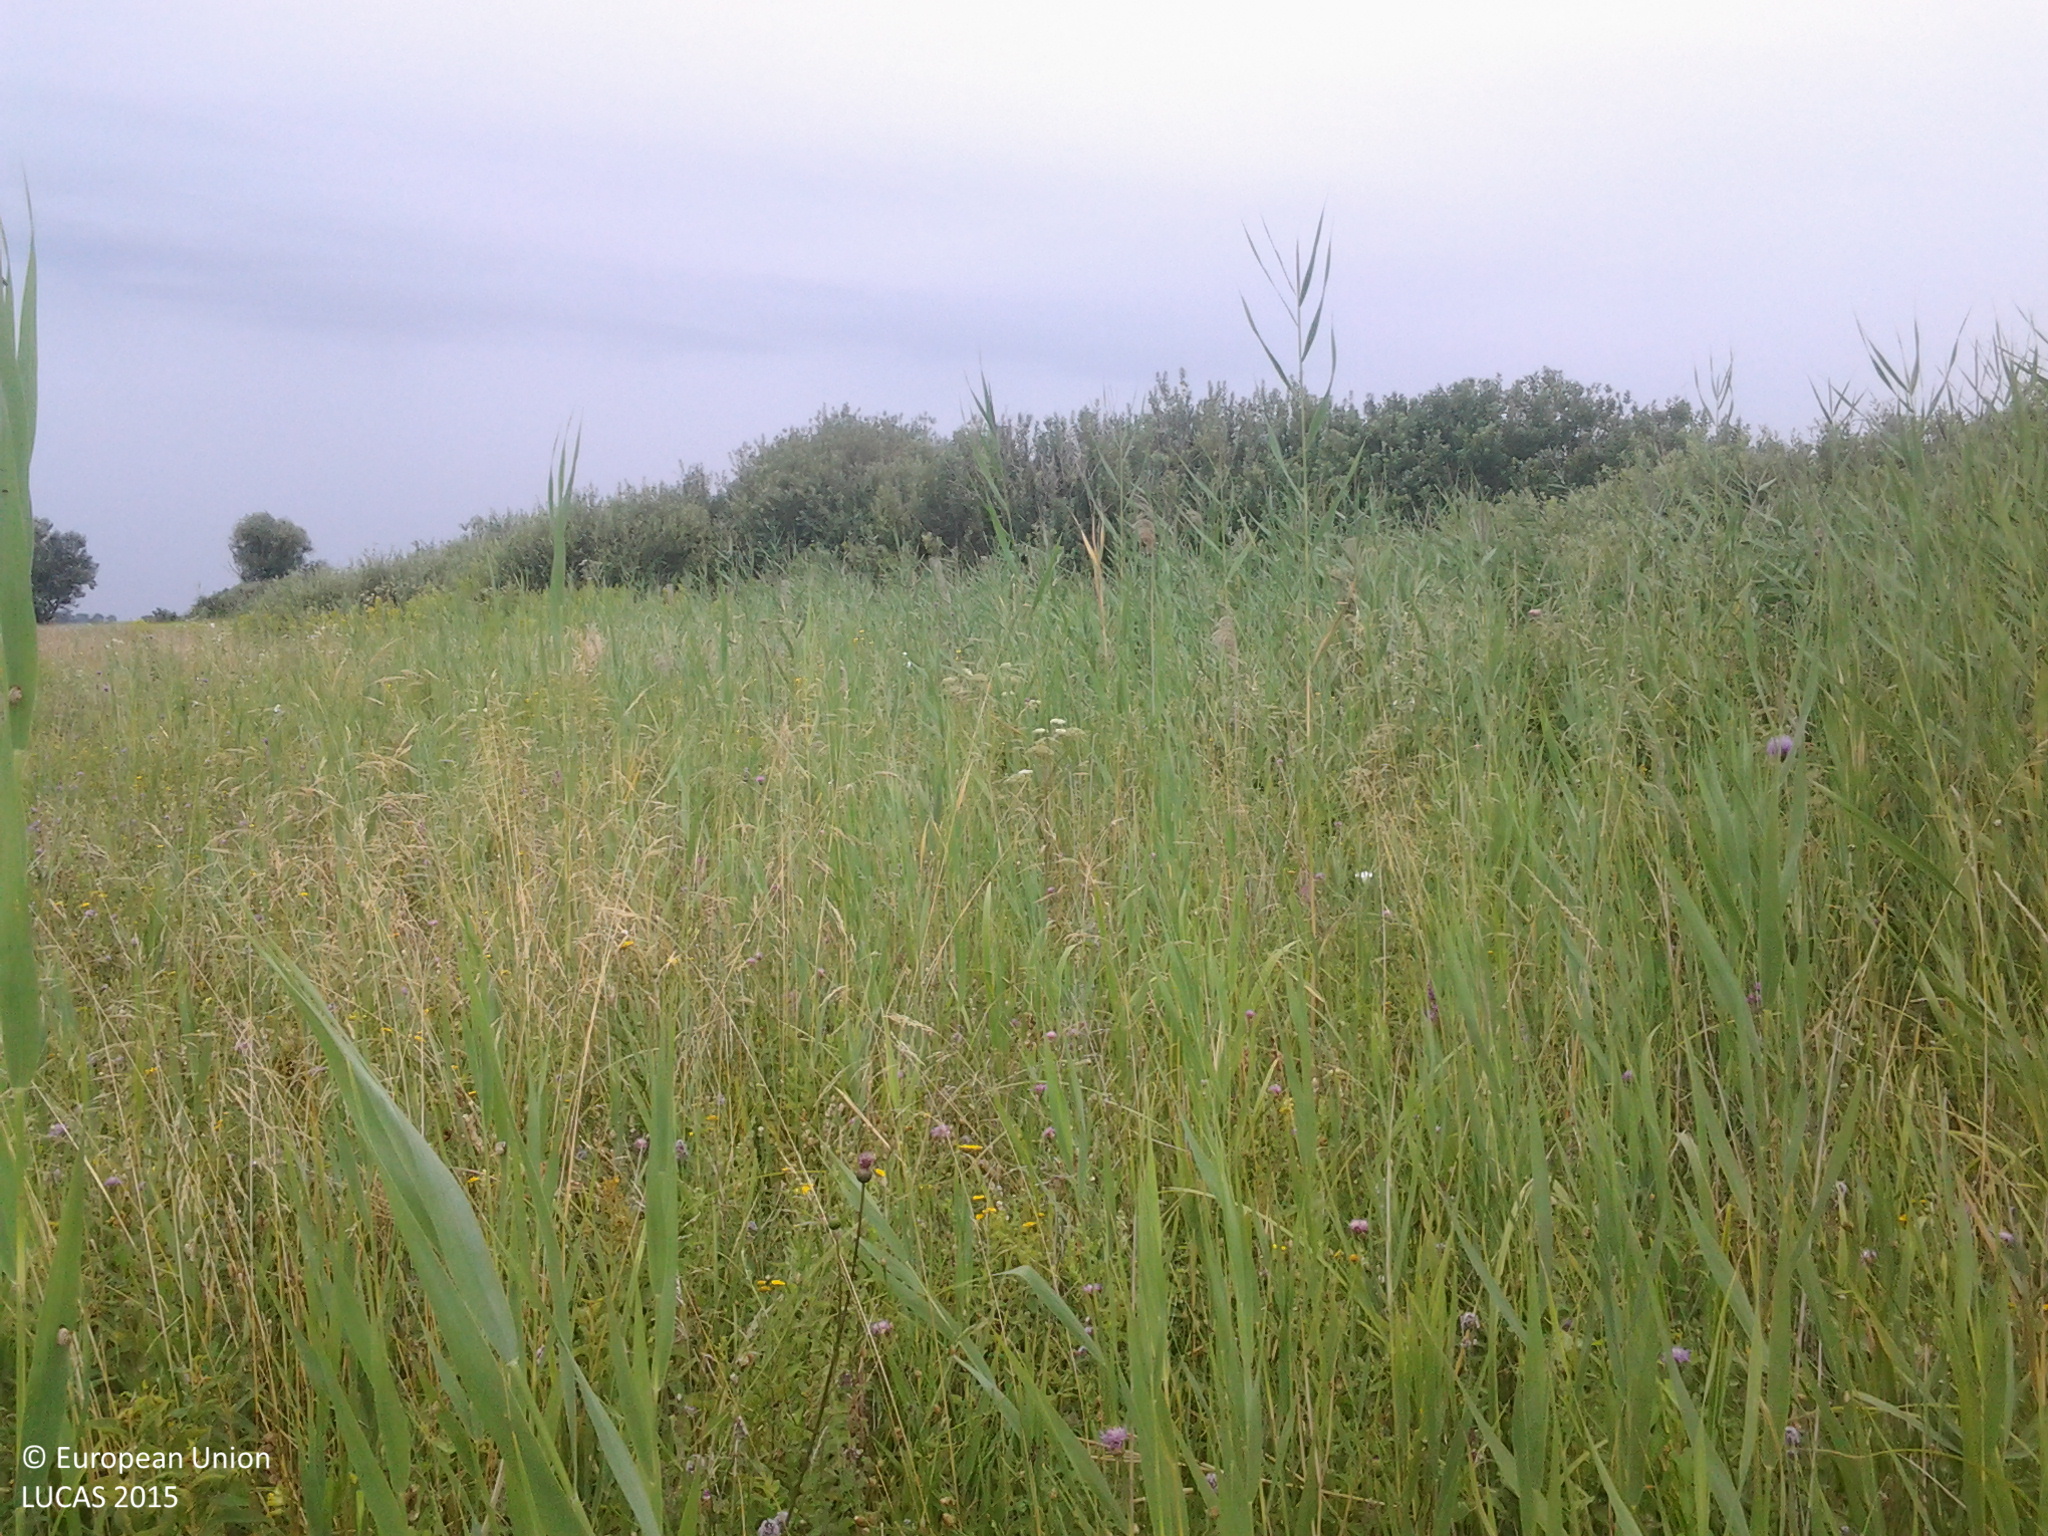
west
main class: Grassland
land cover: Grassland without tree/shrub cover
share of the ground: > 75 %
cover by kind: herbaceous plants 100 %
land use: Agriculture (excluding fallow land and kitchen gardens)
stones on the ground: < 10 %
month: July
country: HU
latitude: 46.6426
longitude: 19.2000
